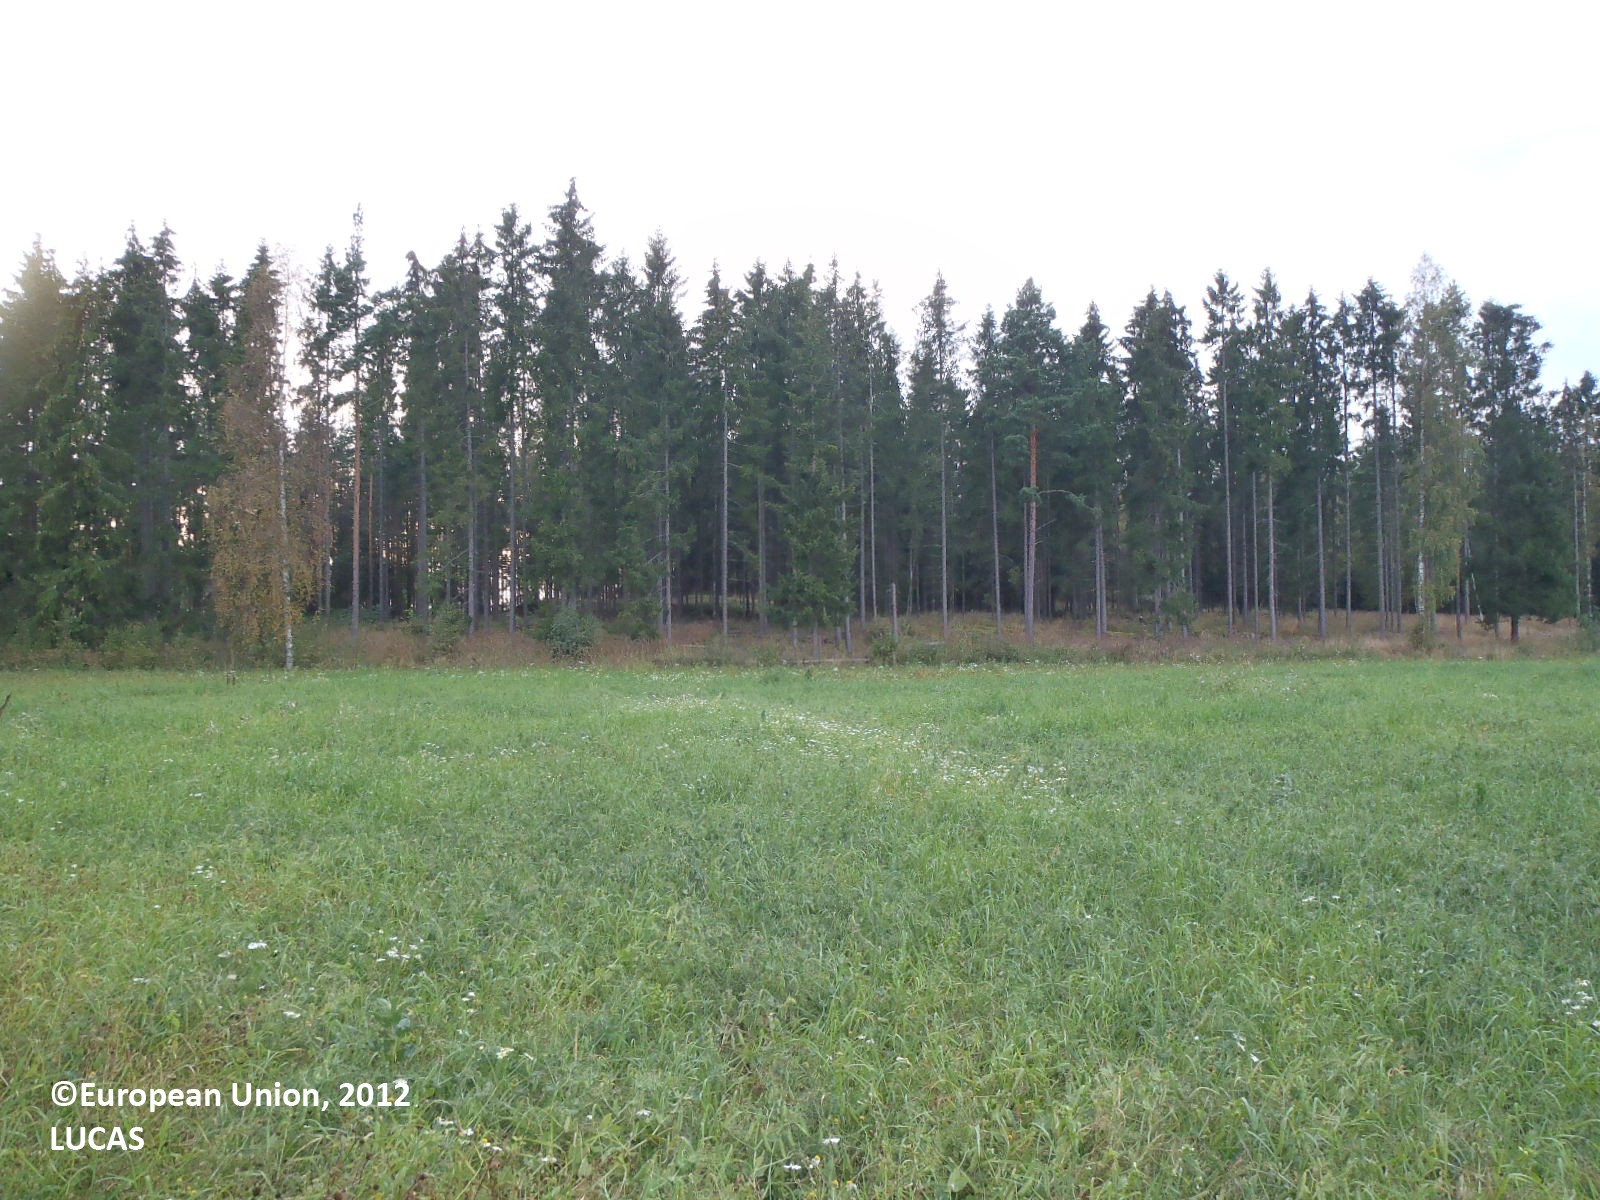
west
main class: Cropland
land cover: Mixed cereals for fodder
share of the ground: > 75 %
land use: Agriculture (excluding fallow land and kitchen gardens)
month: August
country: FI
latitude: 60.9205
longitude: 22.4805
